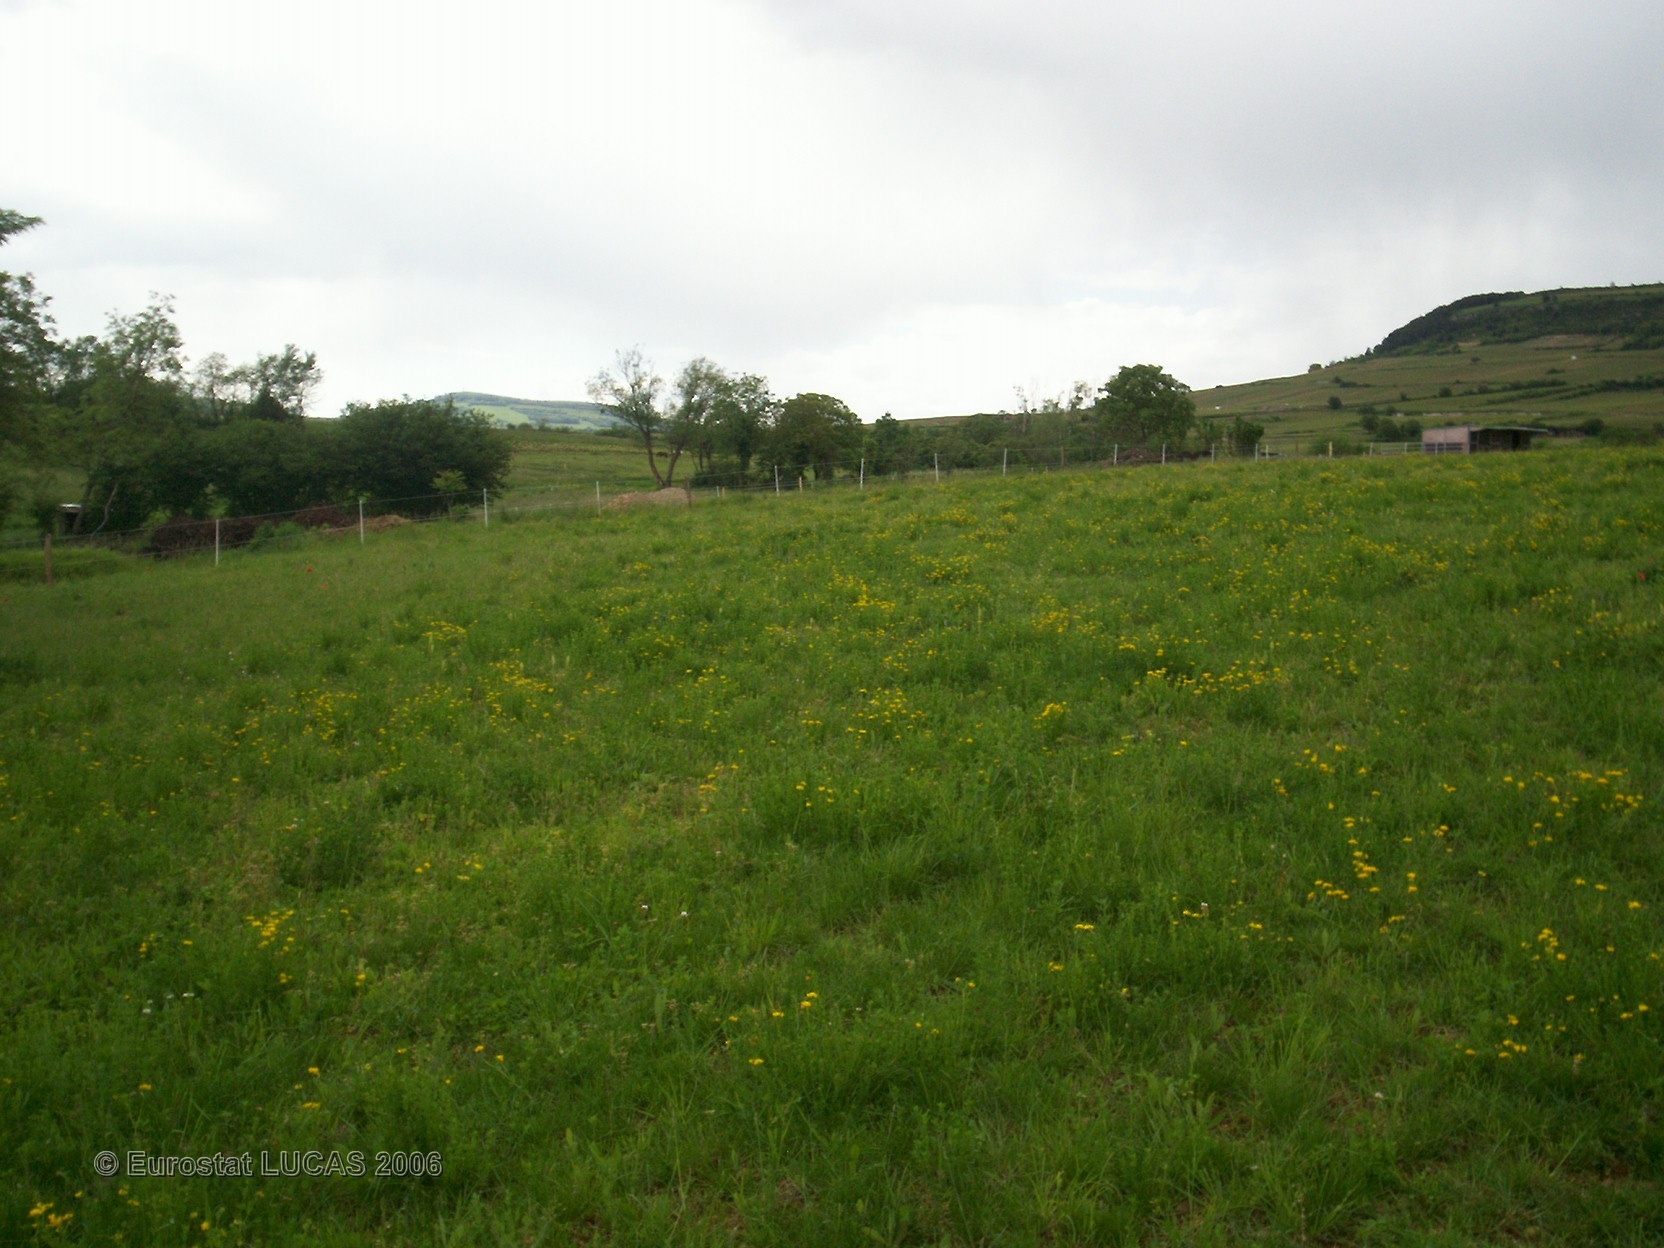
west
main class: Grassland
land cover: Grassland without tree/shrub cover
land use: Agriculture (excluding fallow land and kitchen gardens)
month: May
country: FR
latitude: 46.9048
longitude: 4.6839
